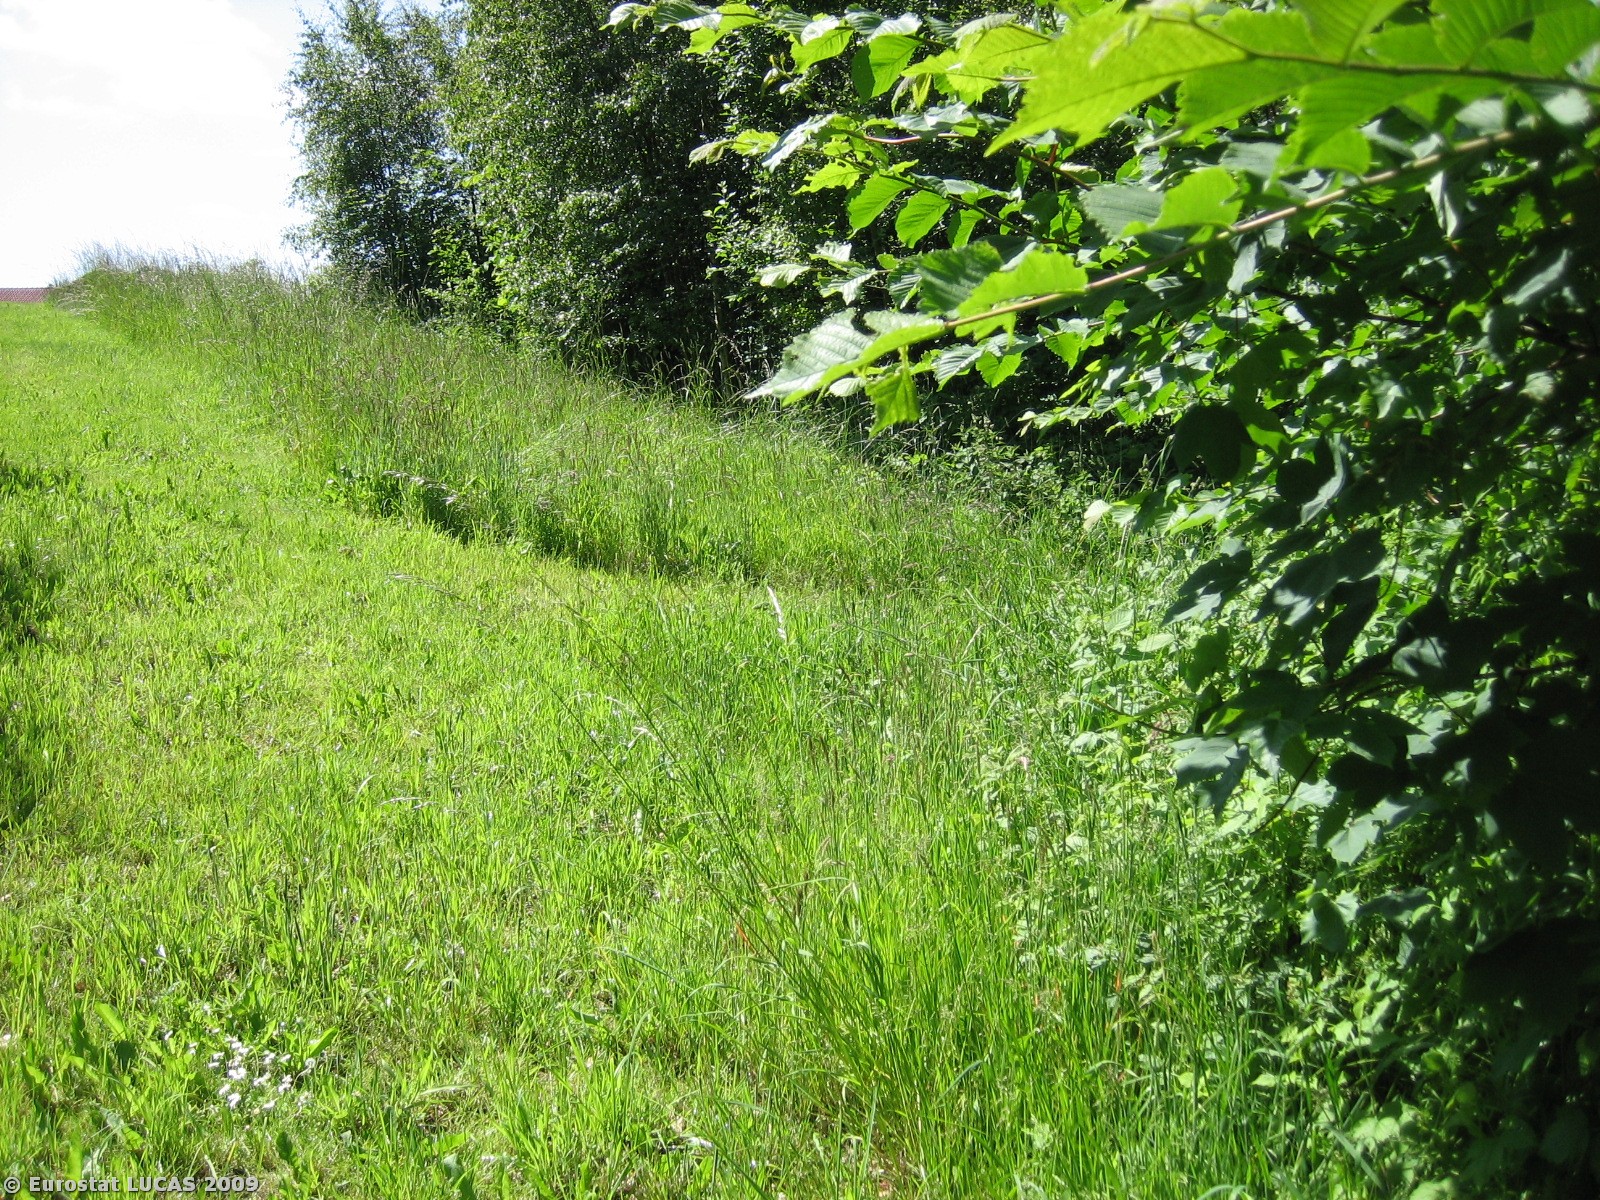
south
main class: Woodland
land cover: Broadleaved woodland
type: mesophytic deciduous forest
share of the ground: > 75 %
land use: Residential
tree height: > 5 m
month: June
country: DK
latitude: 55.9540
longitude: 9.8560
